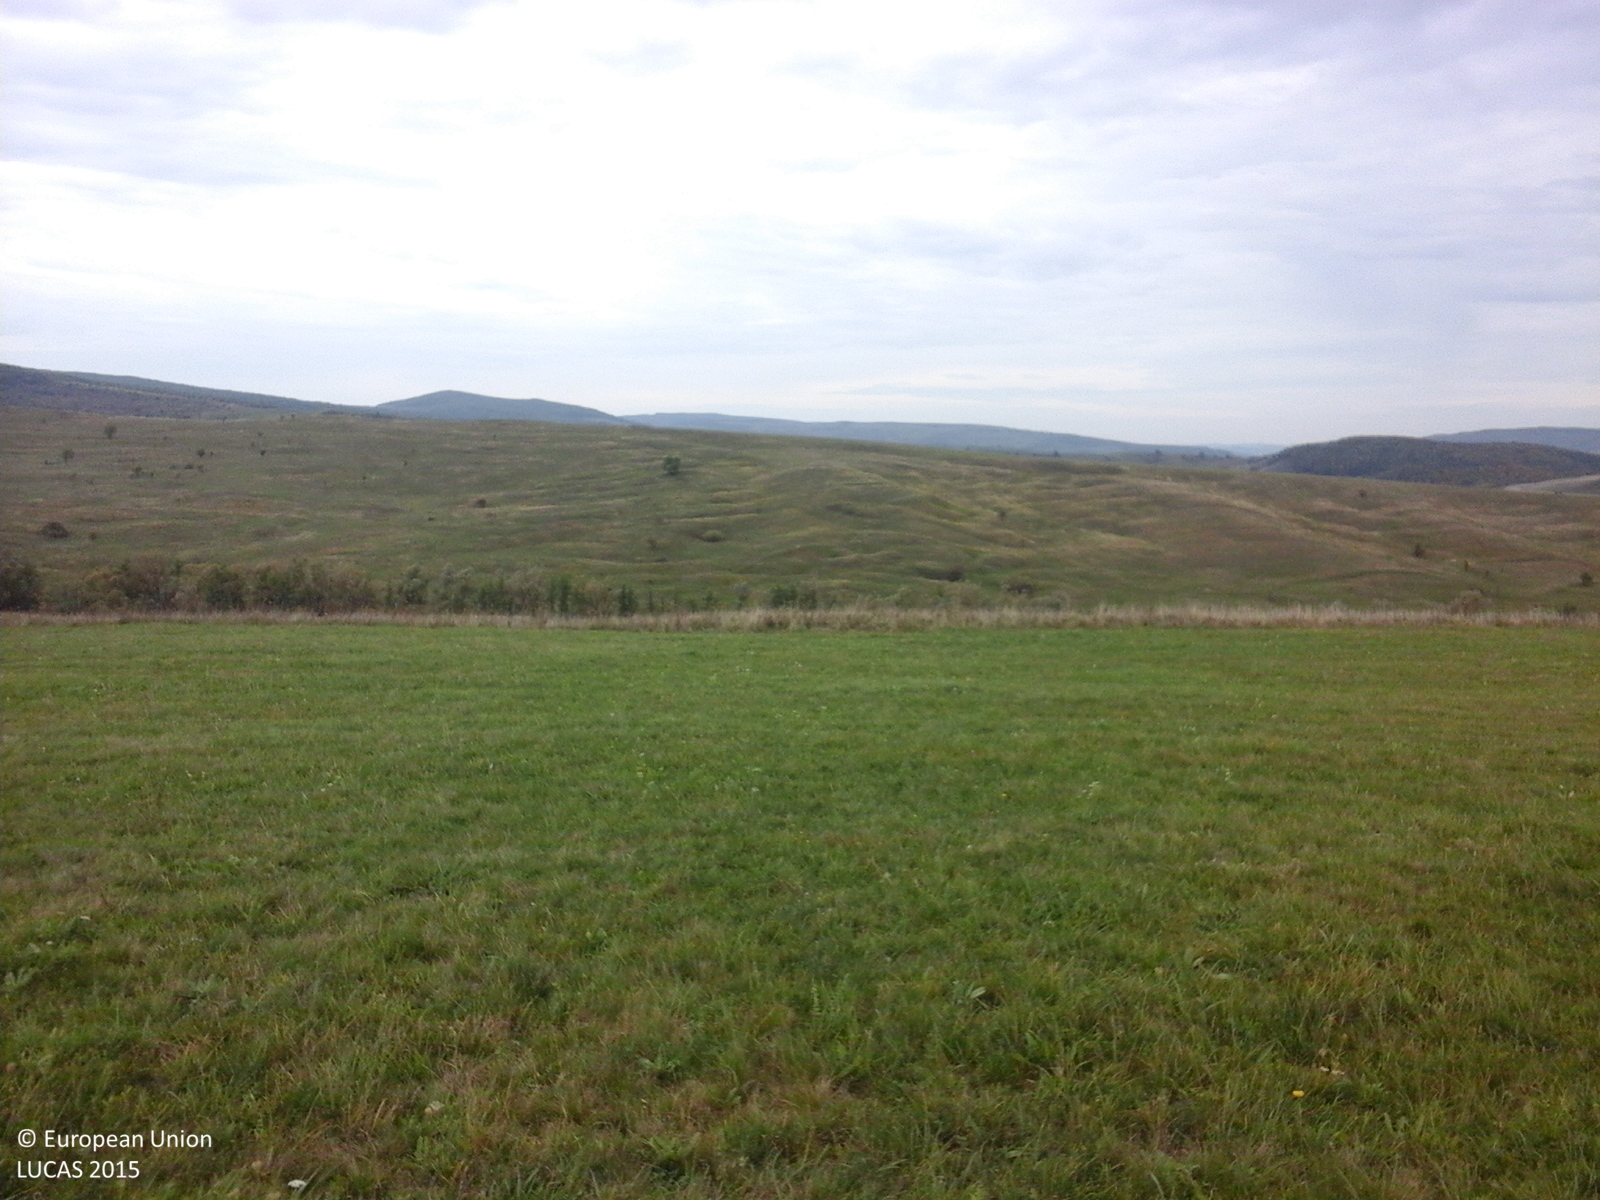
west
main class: Grassland
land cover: Grassland without tree/shrub cover
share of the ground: > 75 %
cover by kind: herbaceous plants 100 %
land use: Agriculture (excluding fallow land and kitchen gardens)
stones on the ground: < 10 %
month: October
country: RO
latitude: 46.2335
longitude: 25.2863
